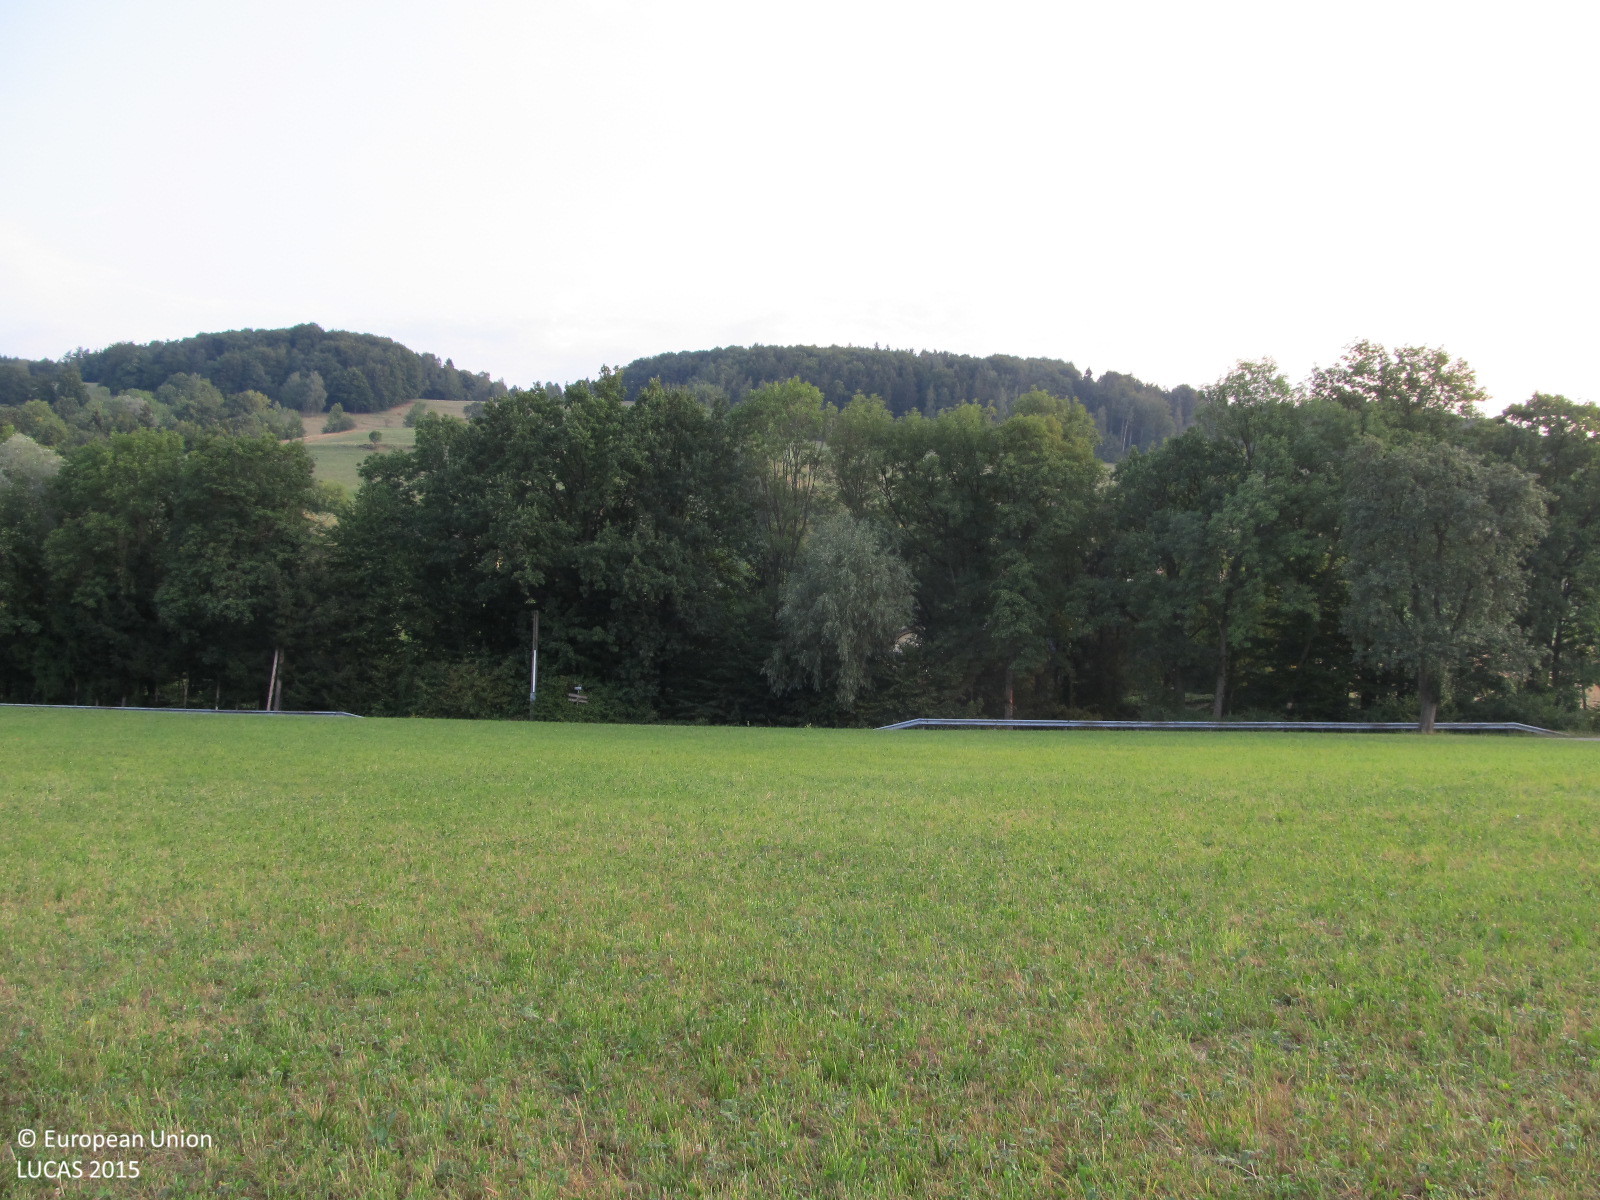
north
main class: Grassland
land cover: Grassland without tree/shrub cover
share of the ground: > 75 %
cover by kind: herbaceous plants 100 %
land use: Agriculture (excluding fallow land and kitchen gardens)
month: August
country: AT
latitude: 48.0573
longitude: 15.3552
